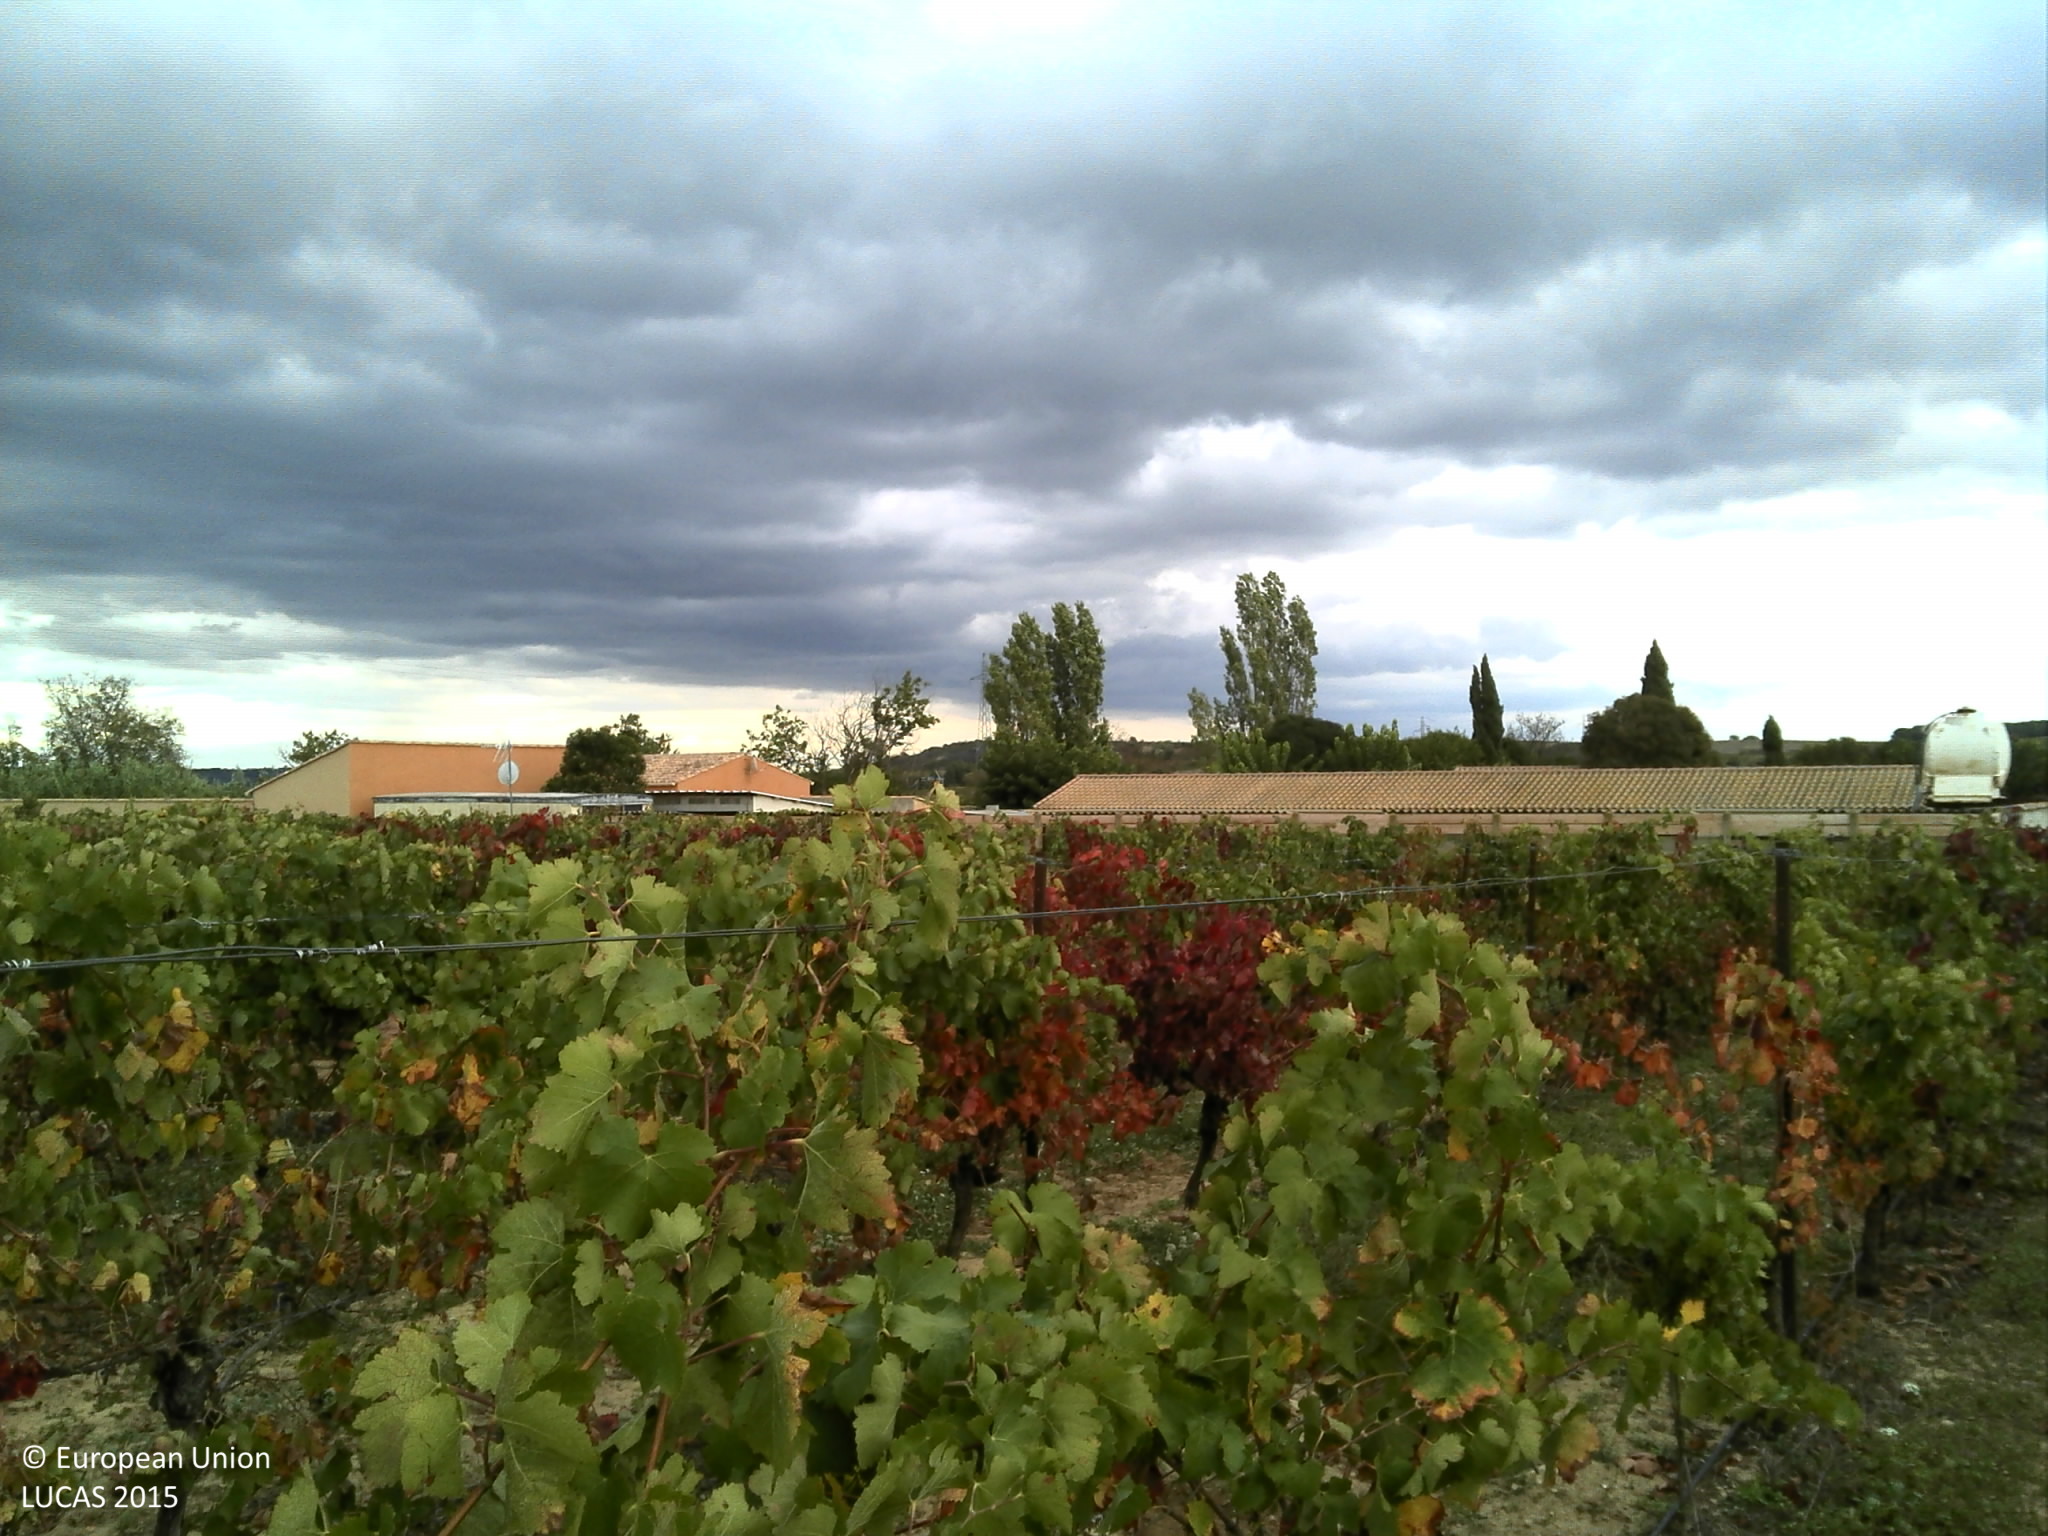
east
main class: Cropland
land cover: Vineyards
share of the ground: 10 - 25 %
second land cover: Spontaneously vegetated surfaces
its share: 50 - 75 %
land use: Agriculture (excluding fallow land and kitchen gardens)
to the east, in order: Vineyards; Spontaneously vegetated surfaces; Artificial constructions in urban areas; Broadleaved woodland; Rivers and streams; Broadleaved woodland; Vineyards; Ditches and canals; Grass margins; Tracks; Grass margins; Vineyards; Tracks; Vineyards
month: October
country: FR
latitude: 43.3629
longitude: 3.1360
